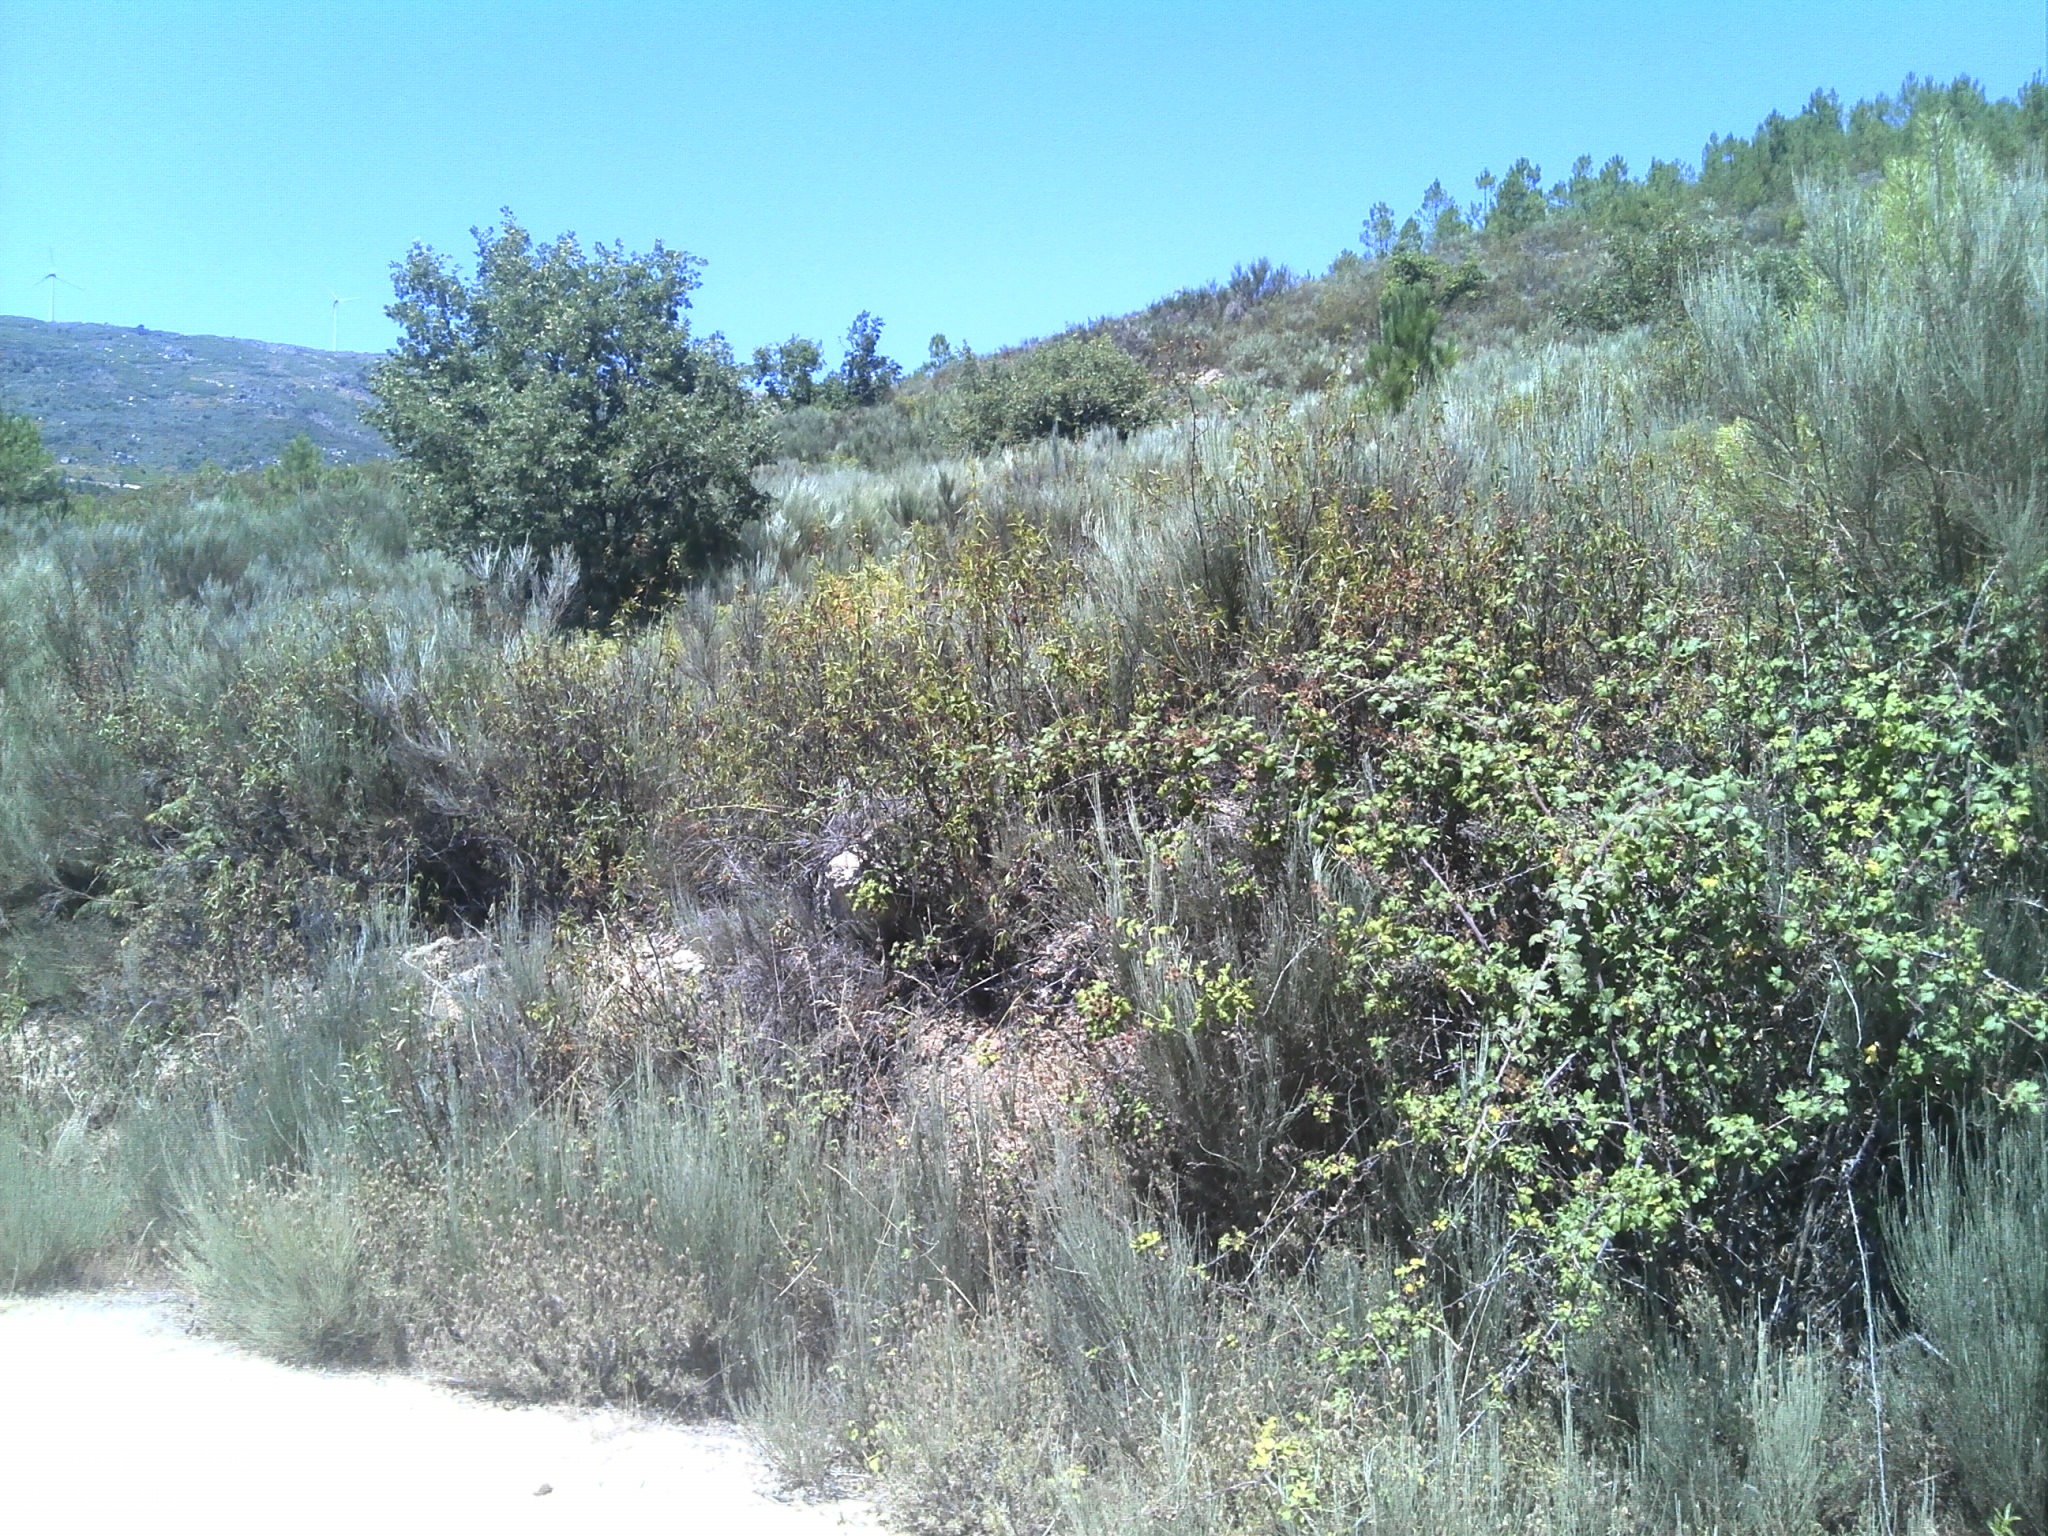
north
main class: Woodland
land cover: Broadleaved woodland
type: broadleaved evergreen forest
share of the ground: 10 - 25 %
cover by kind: herbaceous plants 40 %, unconsolidated bare surface 40 %, broadleaved forest trees 20 %
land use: Forestry
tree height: < 5 m
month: July
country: PT
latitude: 40.4282
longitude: -7.3266
